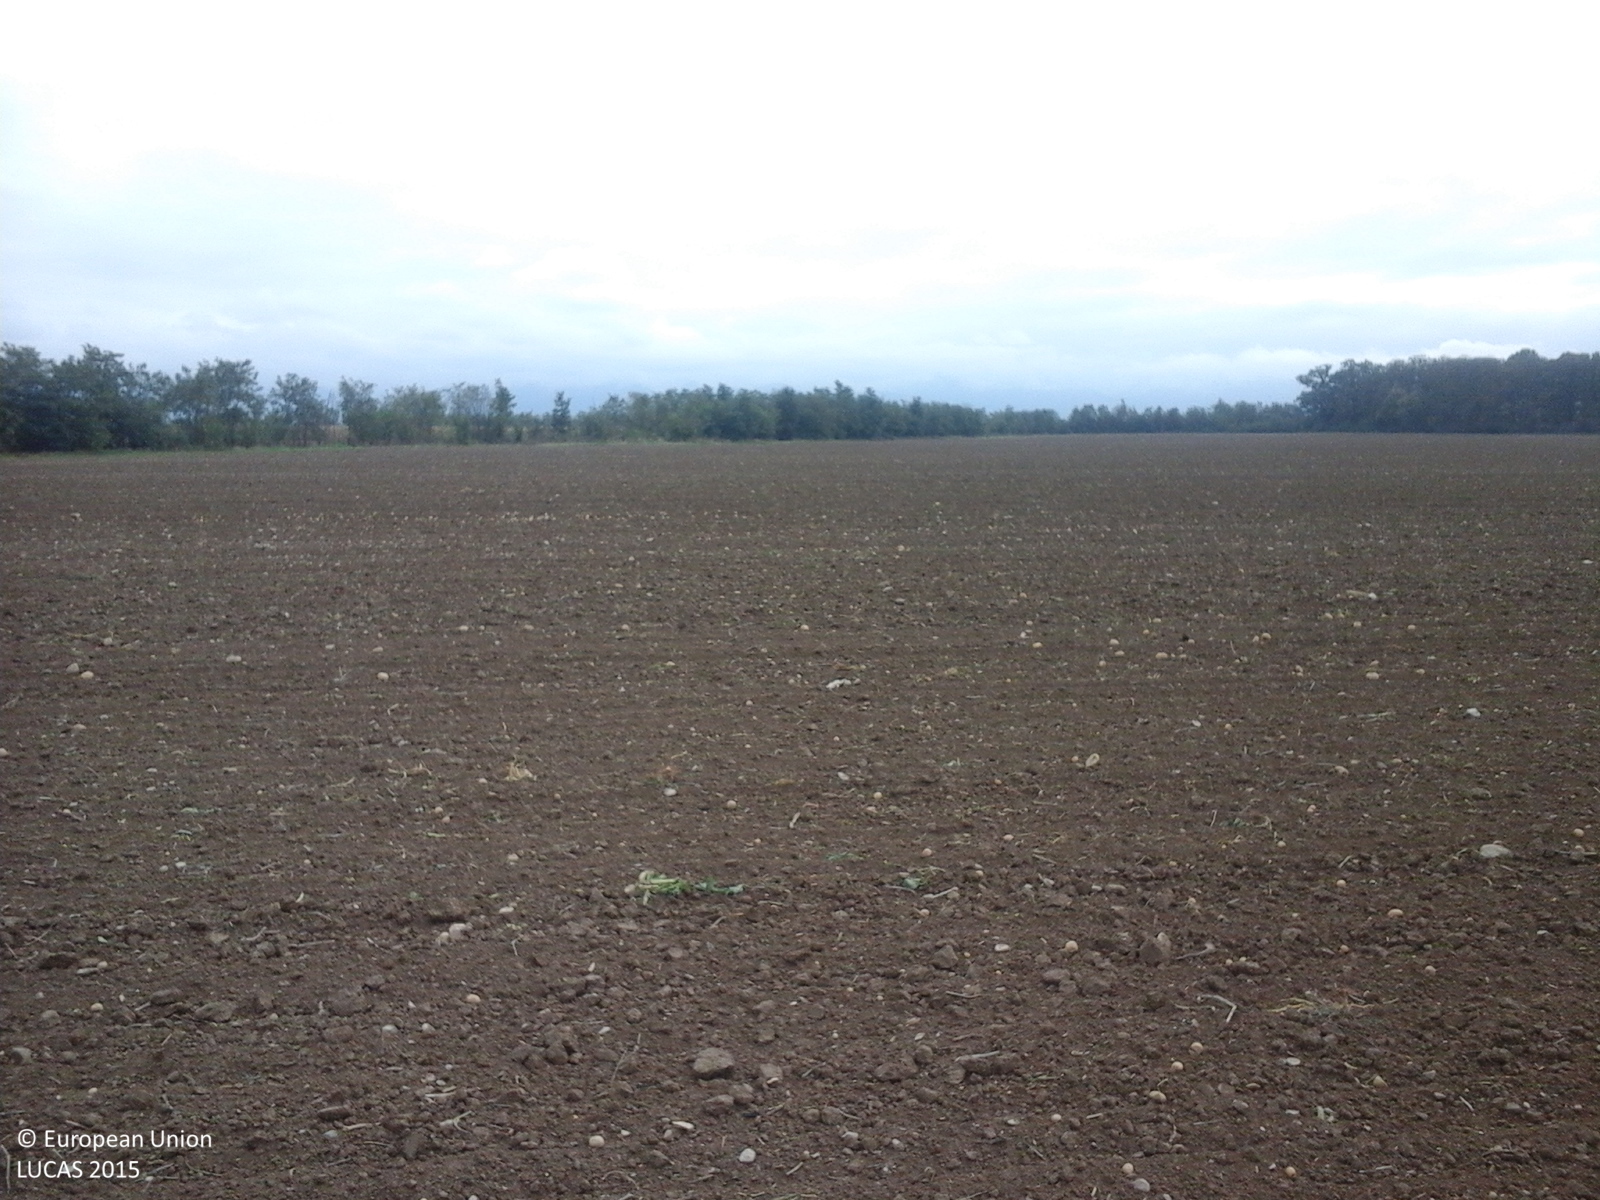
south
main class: Cropland
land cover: Potatoes
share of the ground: 50 - 75 %
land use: Agriculture (excluding fallow land and kitchen gardens)
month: October
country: RO
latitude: 45.7916
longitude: 24.7915
